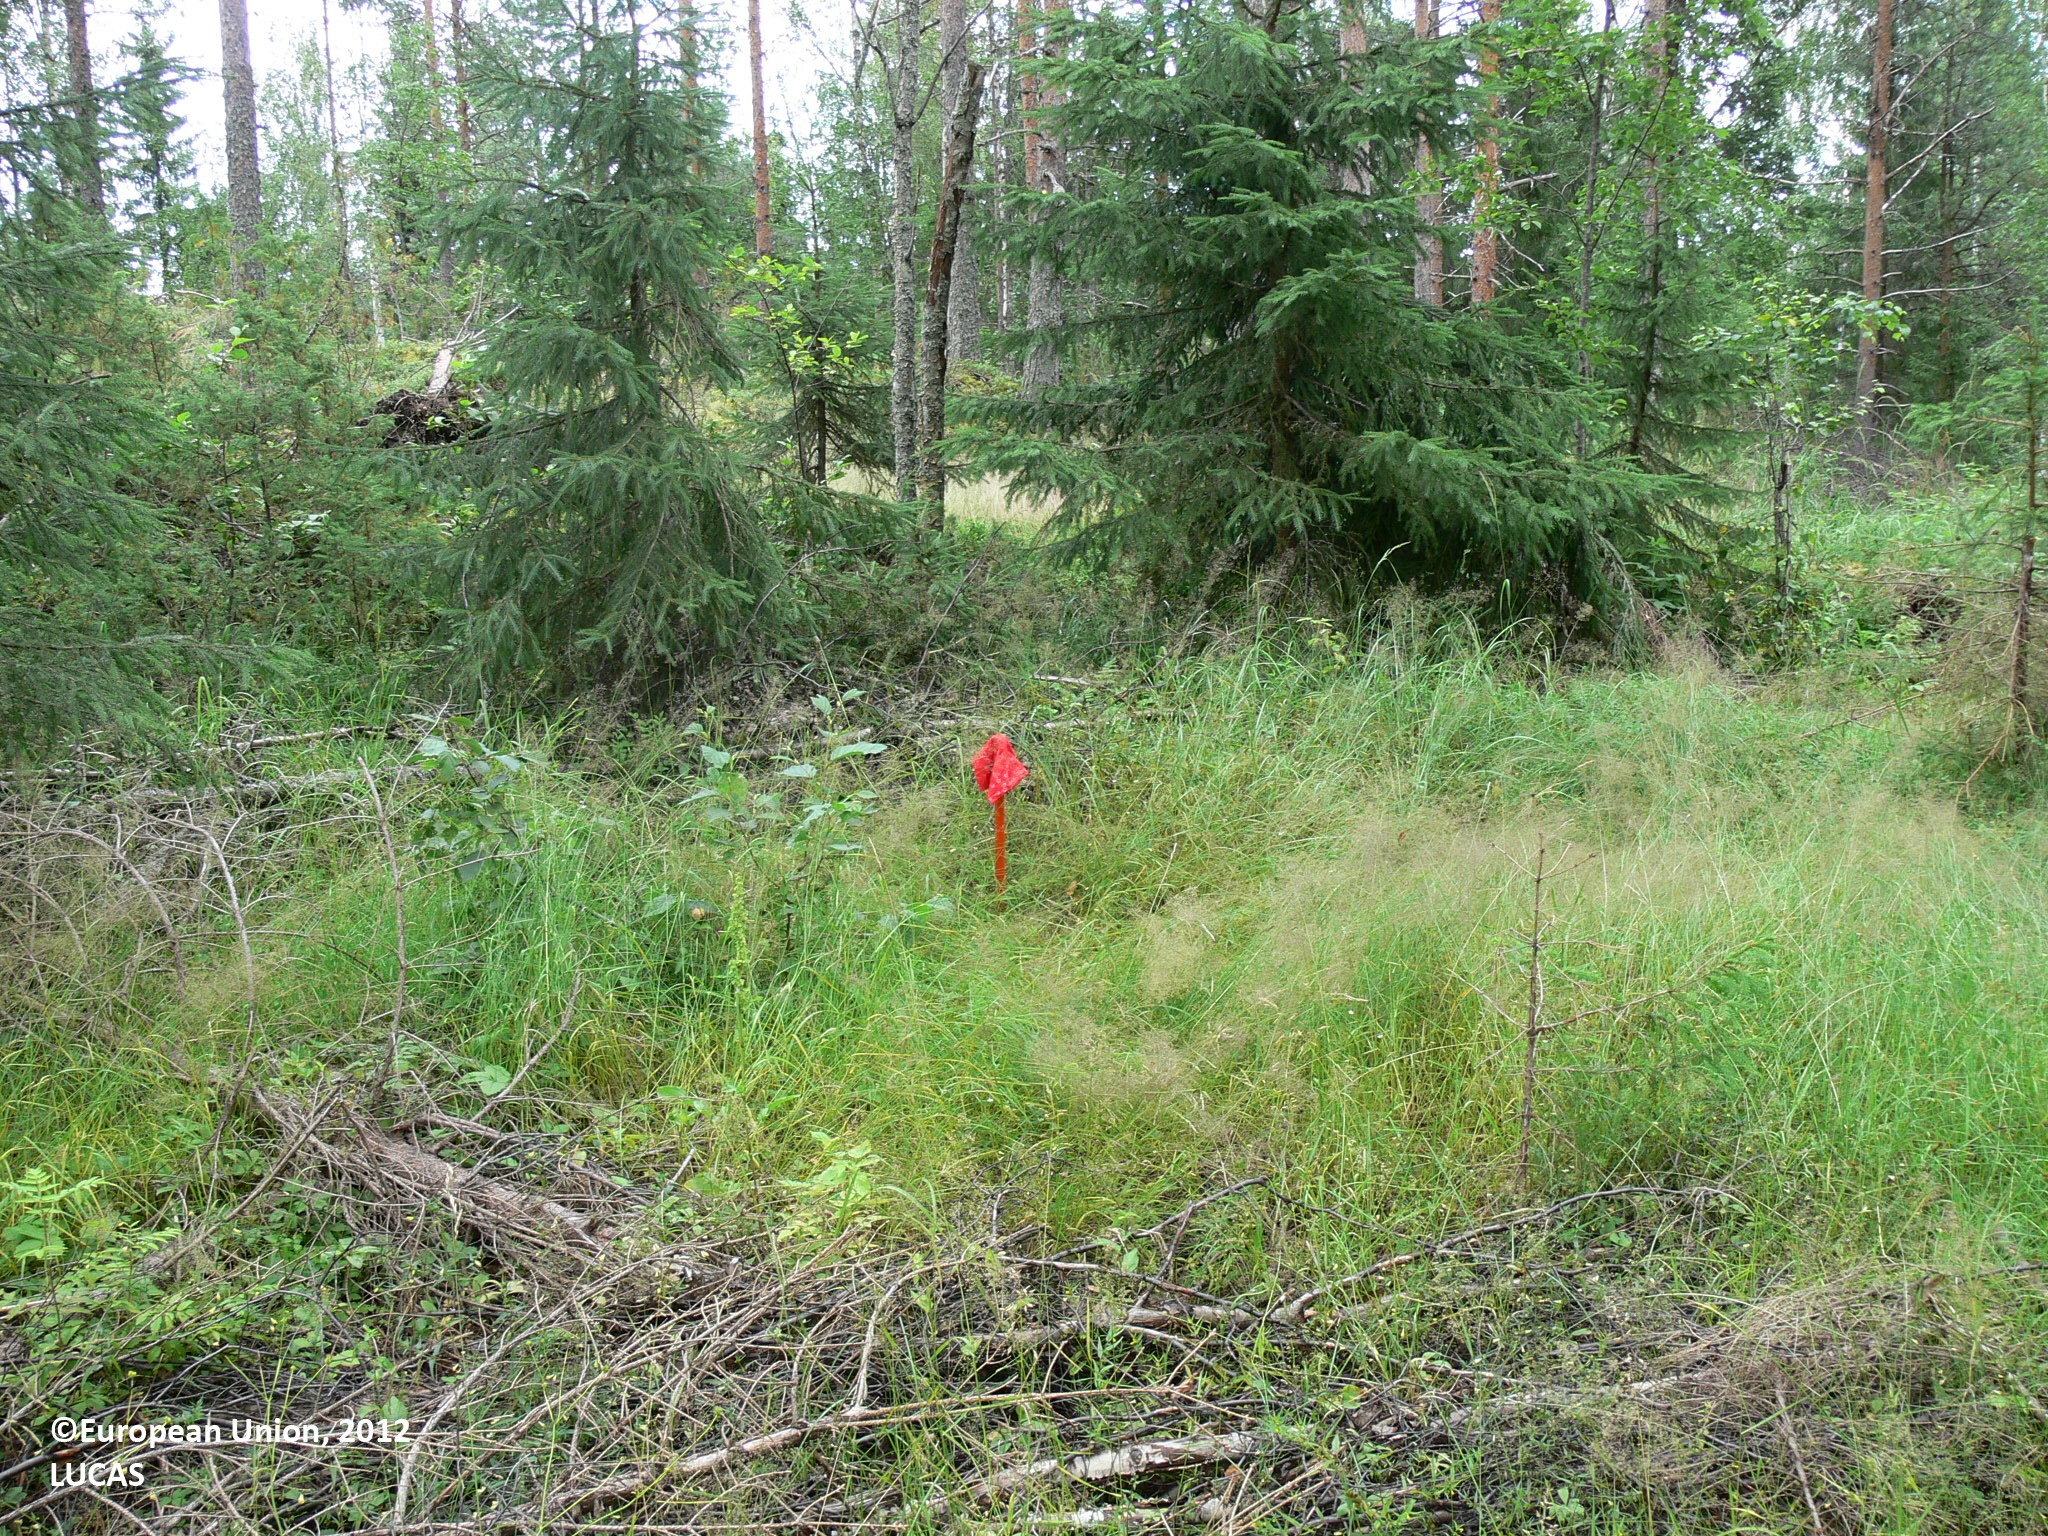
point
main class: Woodland
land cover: Other mixed woodland
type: boreal forest
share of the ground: 50 - 75 %
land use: Forestry
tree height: > 5 m
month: July
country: FI
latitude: 63.1808
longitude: 29.3984
